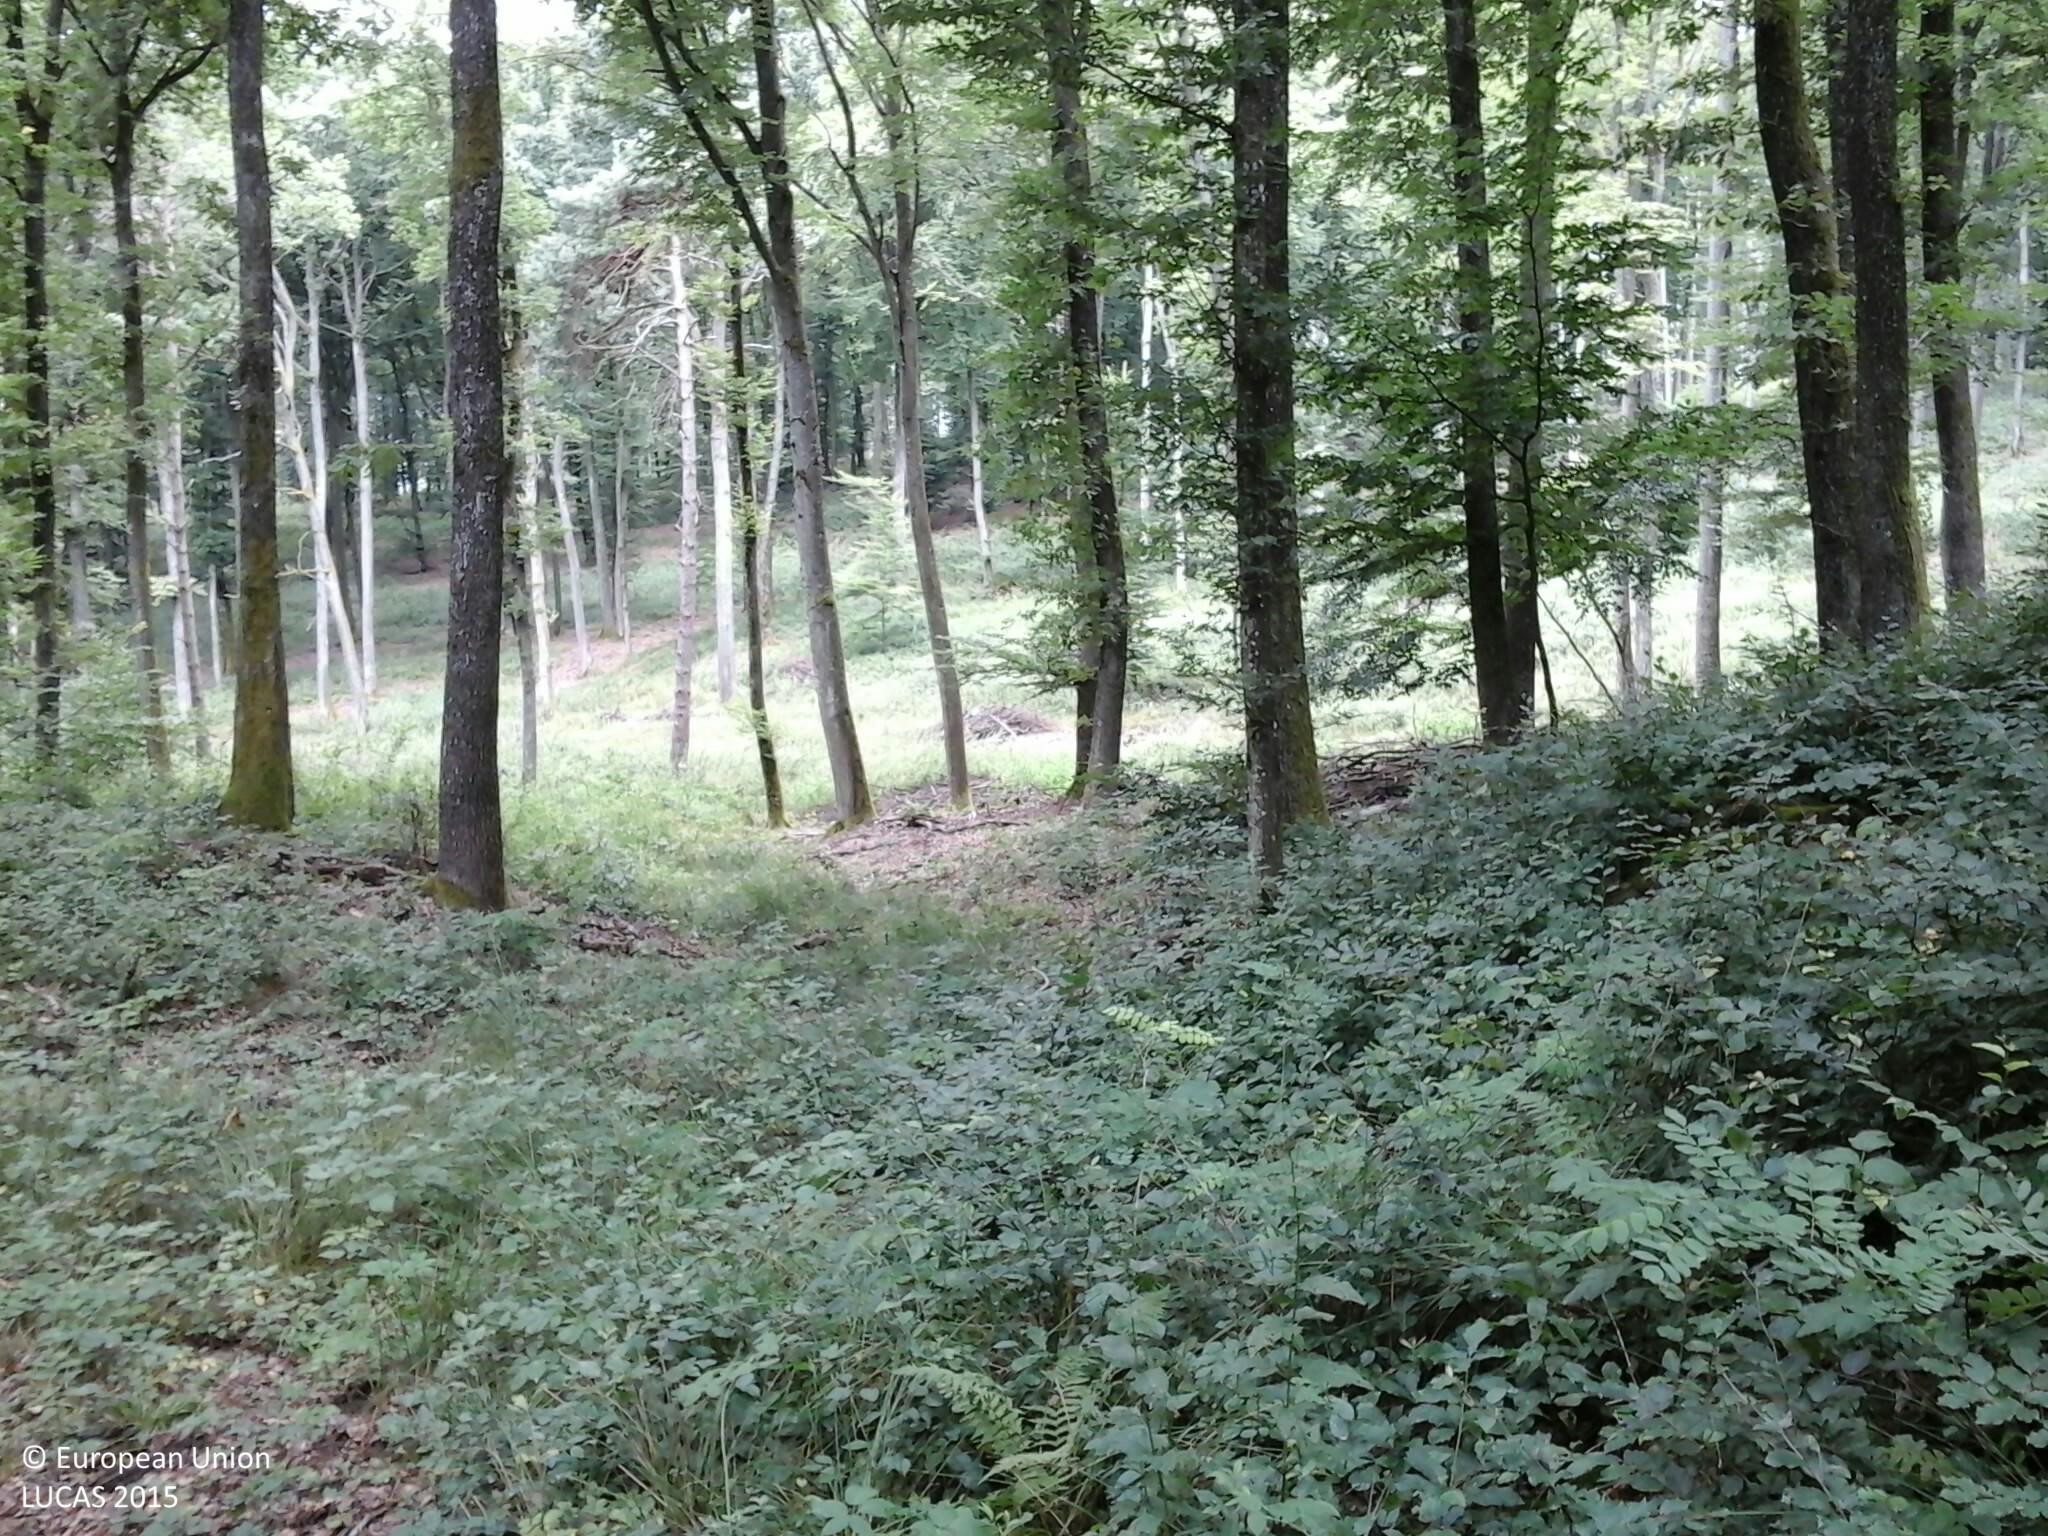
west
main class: Woodland
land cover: Broadleaved woodland
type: beech forest
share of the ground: > 75 %
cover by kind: broadleaved forest trees 85 %, shrubs 10 %, herbaceous plants 5 %
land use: Forestry
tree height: > 5 m
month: July
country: HU
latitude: 46.7733
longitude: 16.4055
